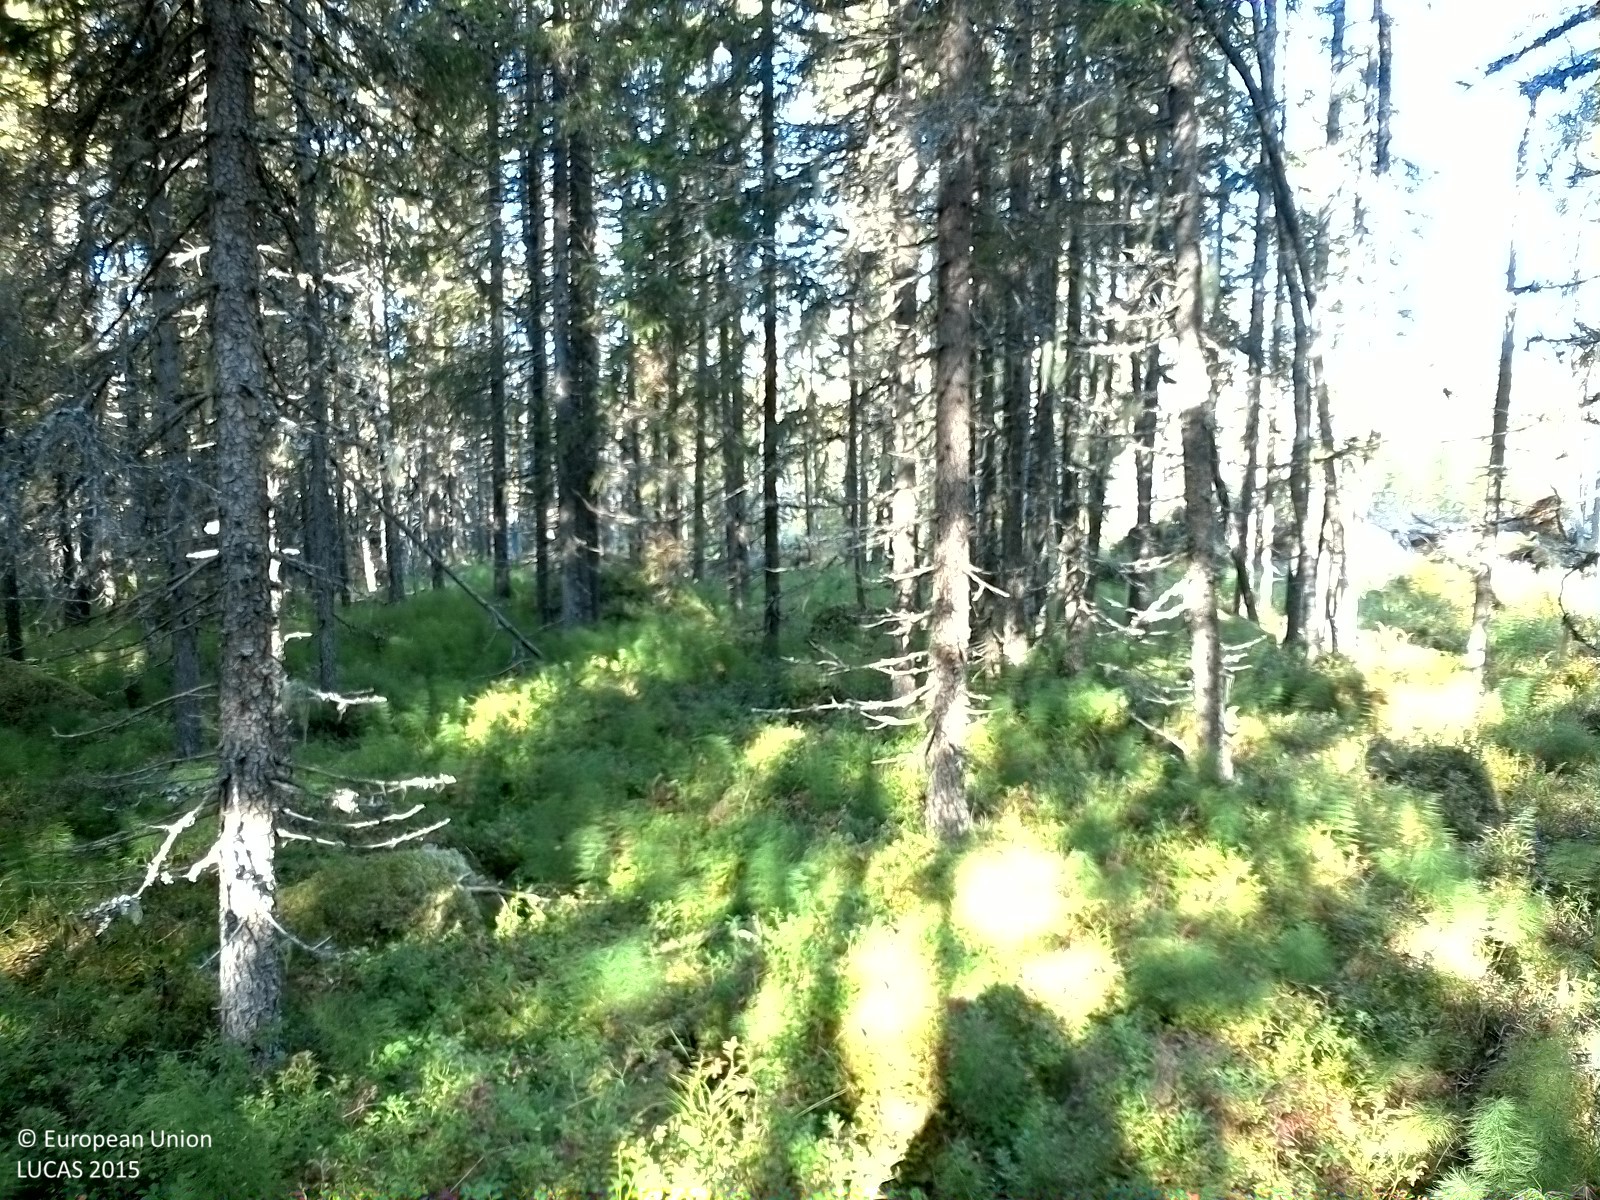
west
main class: Woodland
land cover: Spruce dominated coniferous woodland
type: boreal forest
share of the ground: 50 - 75 %
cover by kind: coniferous forest trees 50 %, shrubs 30 %, herbaceous plants 15 %, broadleaved forest trees 5 %
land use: Forestry
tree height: > 5 m
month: September
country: SE
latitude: 62.5609
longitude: 16.1064
